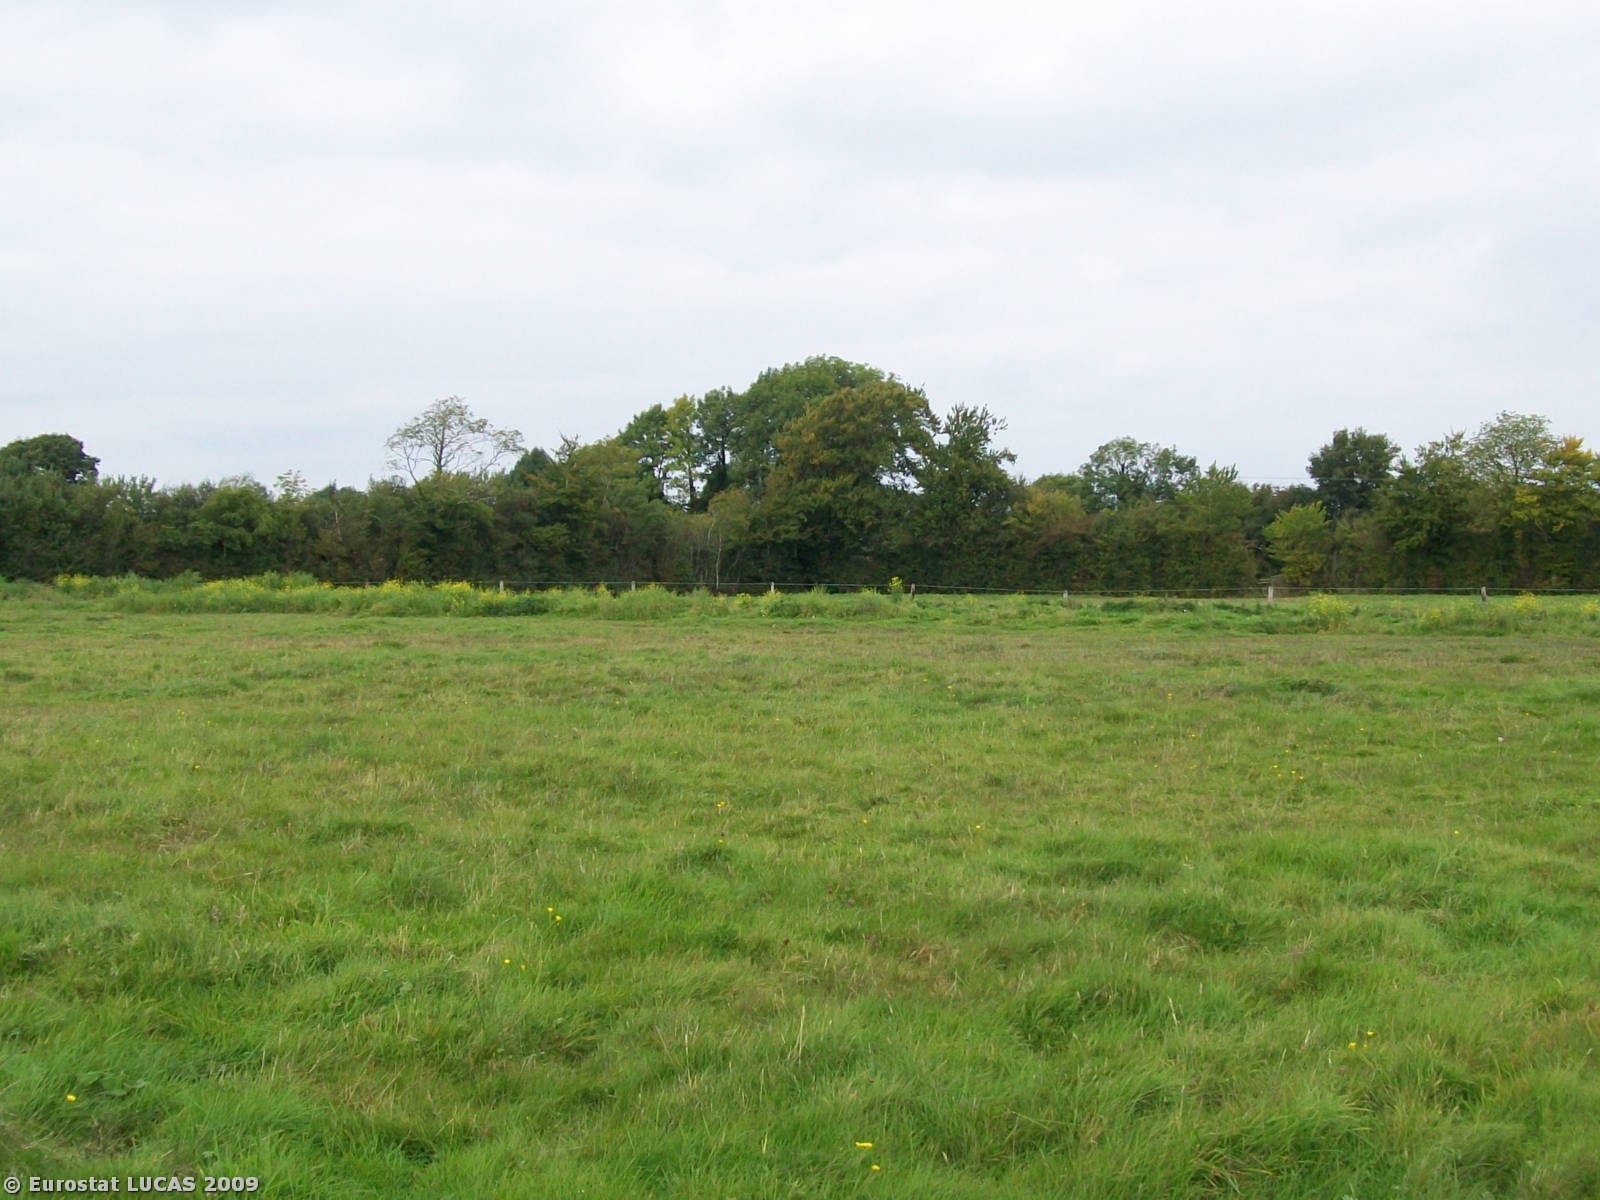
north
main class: Grassland
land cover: Grassland without tree/shrub cover
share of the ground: > 75 %
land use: Agriculture (excluding fallow land and kitchen gardens)
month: September
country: IE
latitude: 52.9599
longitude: -7.8717
